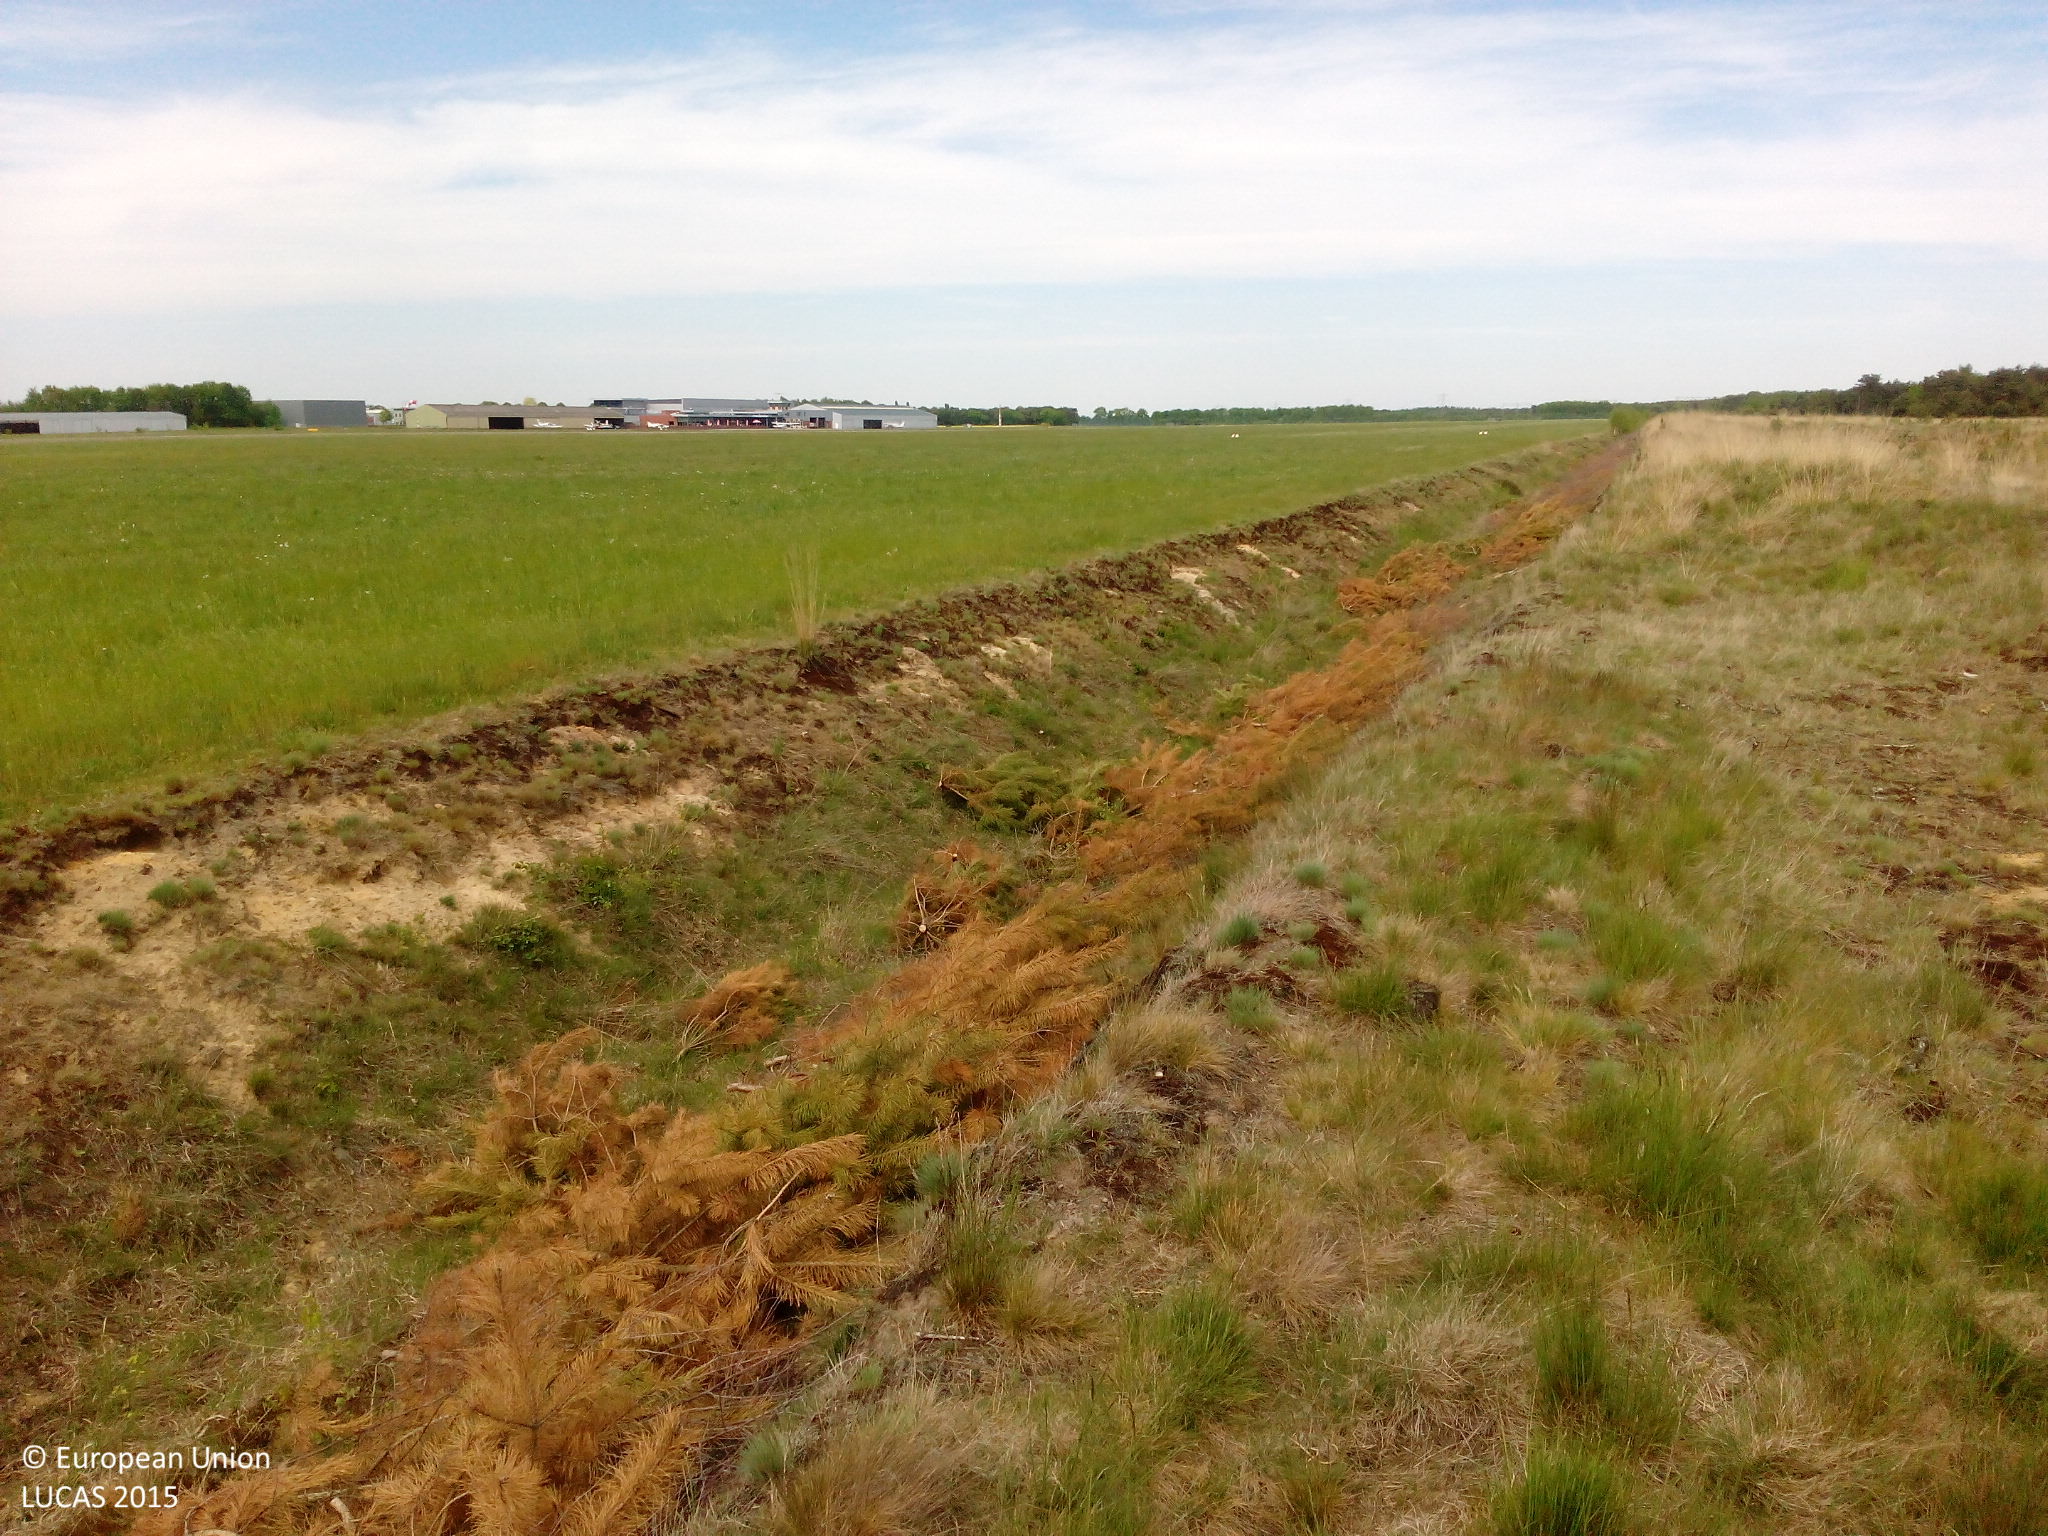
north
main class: Grassland
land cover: Grassland without tree/shrub cover
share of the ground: > 75 %
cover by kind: herbaceous plants 100 %
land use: Air transport
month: May
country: NL
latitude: 51.2518
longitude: 5.5998
